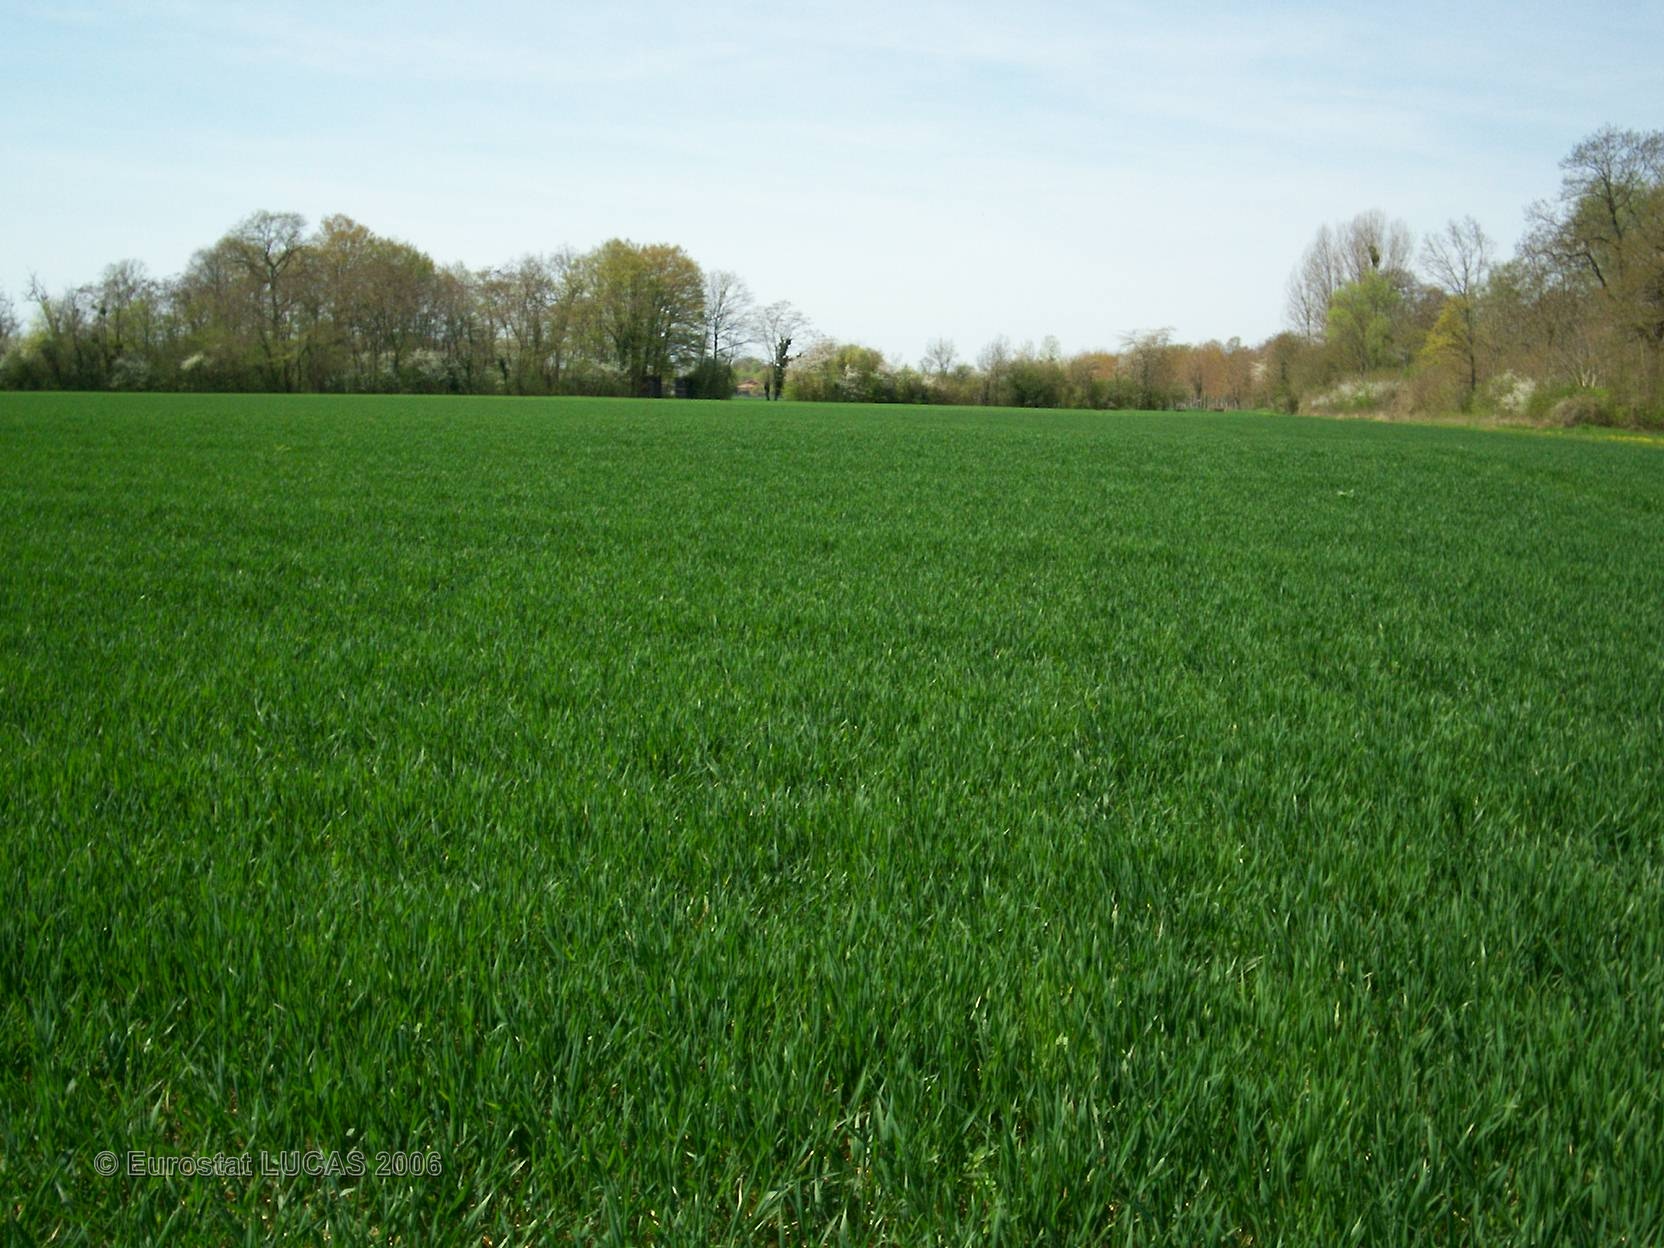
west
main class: Cropland
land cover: Common wheat
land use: Agriculture (excluding fallow land and kitchen gardens)
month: April
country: FR
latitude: 48.4440
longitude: 4.4409
